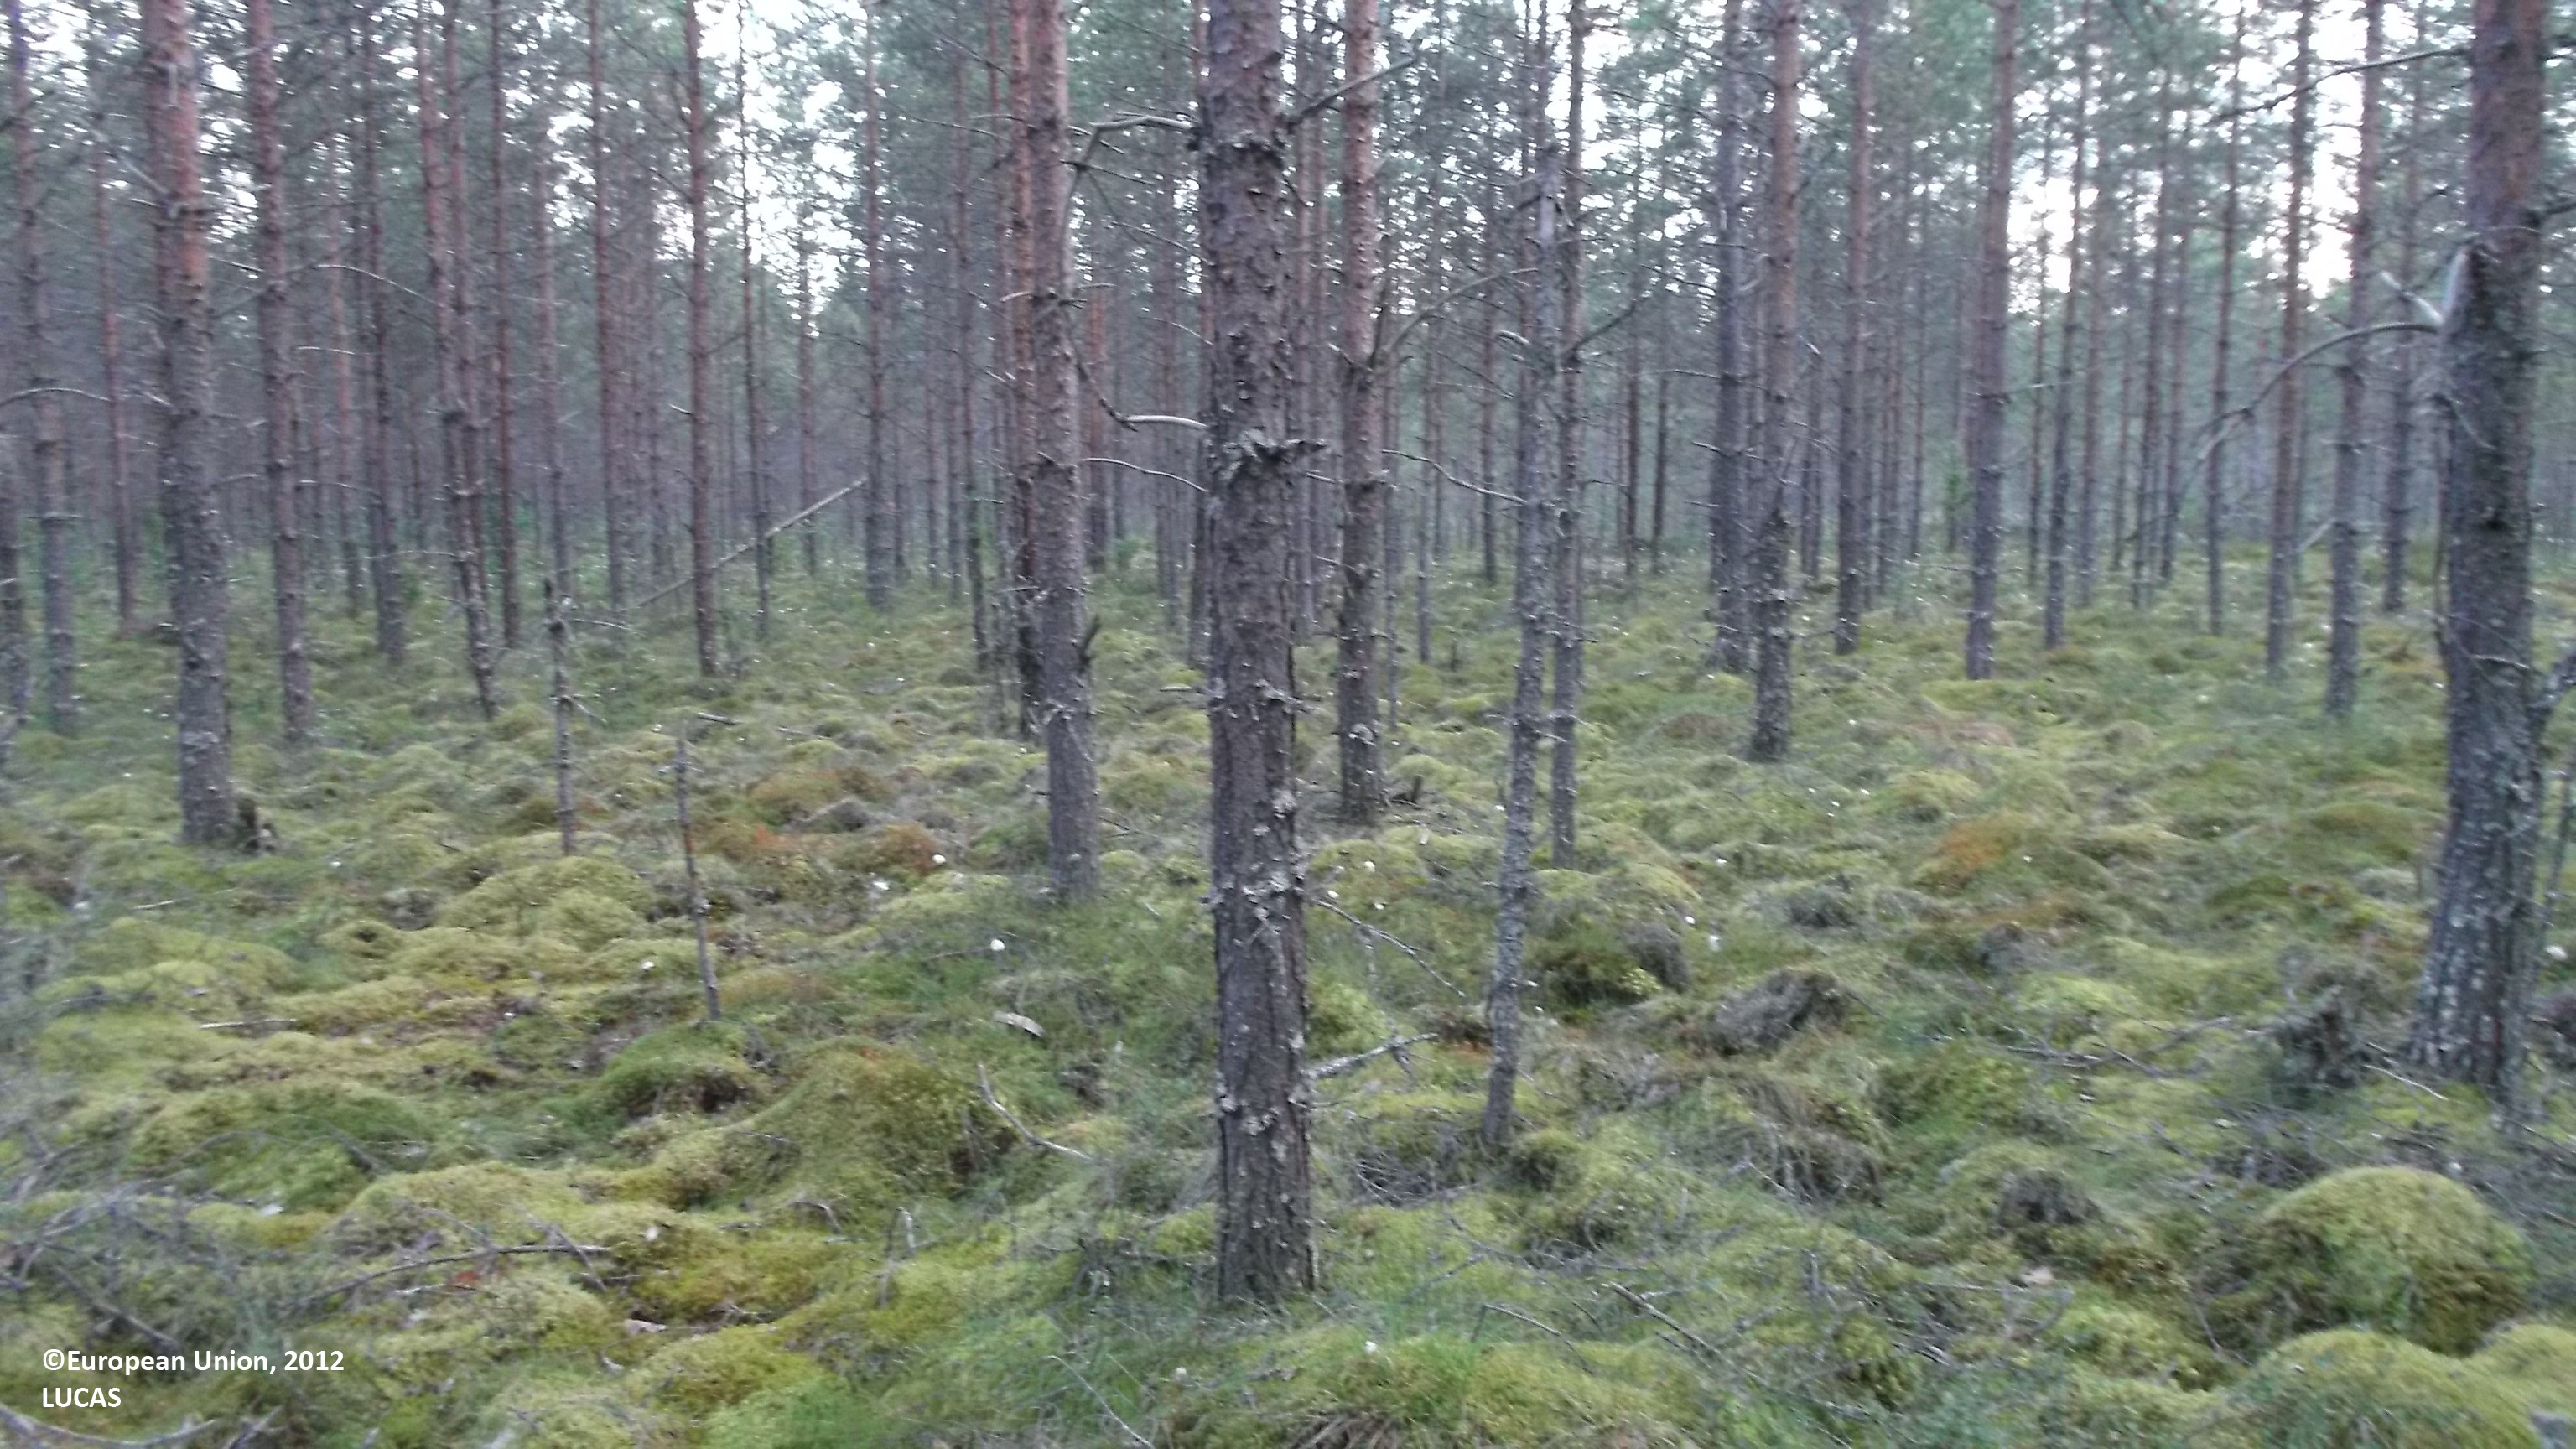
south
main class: Woodland
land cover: Pine dominated coniferous woodland
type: mire and swamp forests
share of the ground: 25 - 50 %
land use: Semi-natural and natural areas not in use
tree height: > 5 m
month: July
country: FI
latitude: 63.3632
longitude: 24.4549
